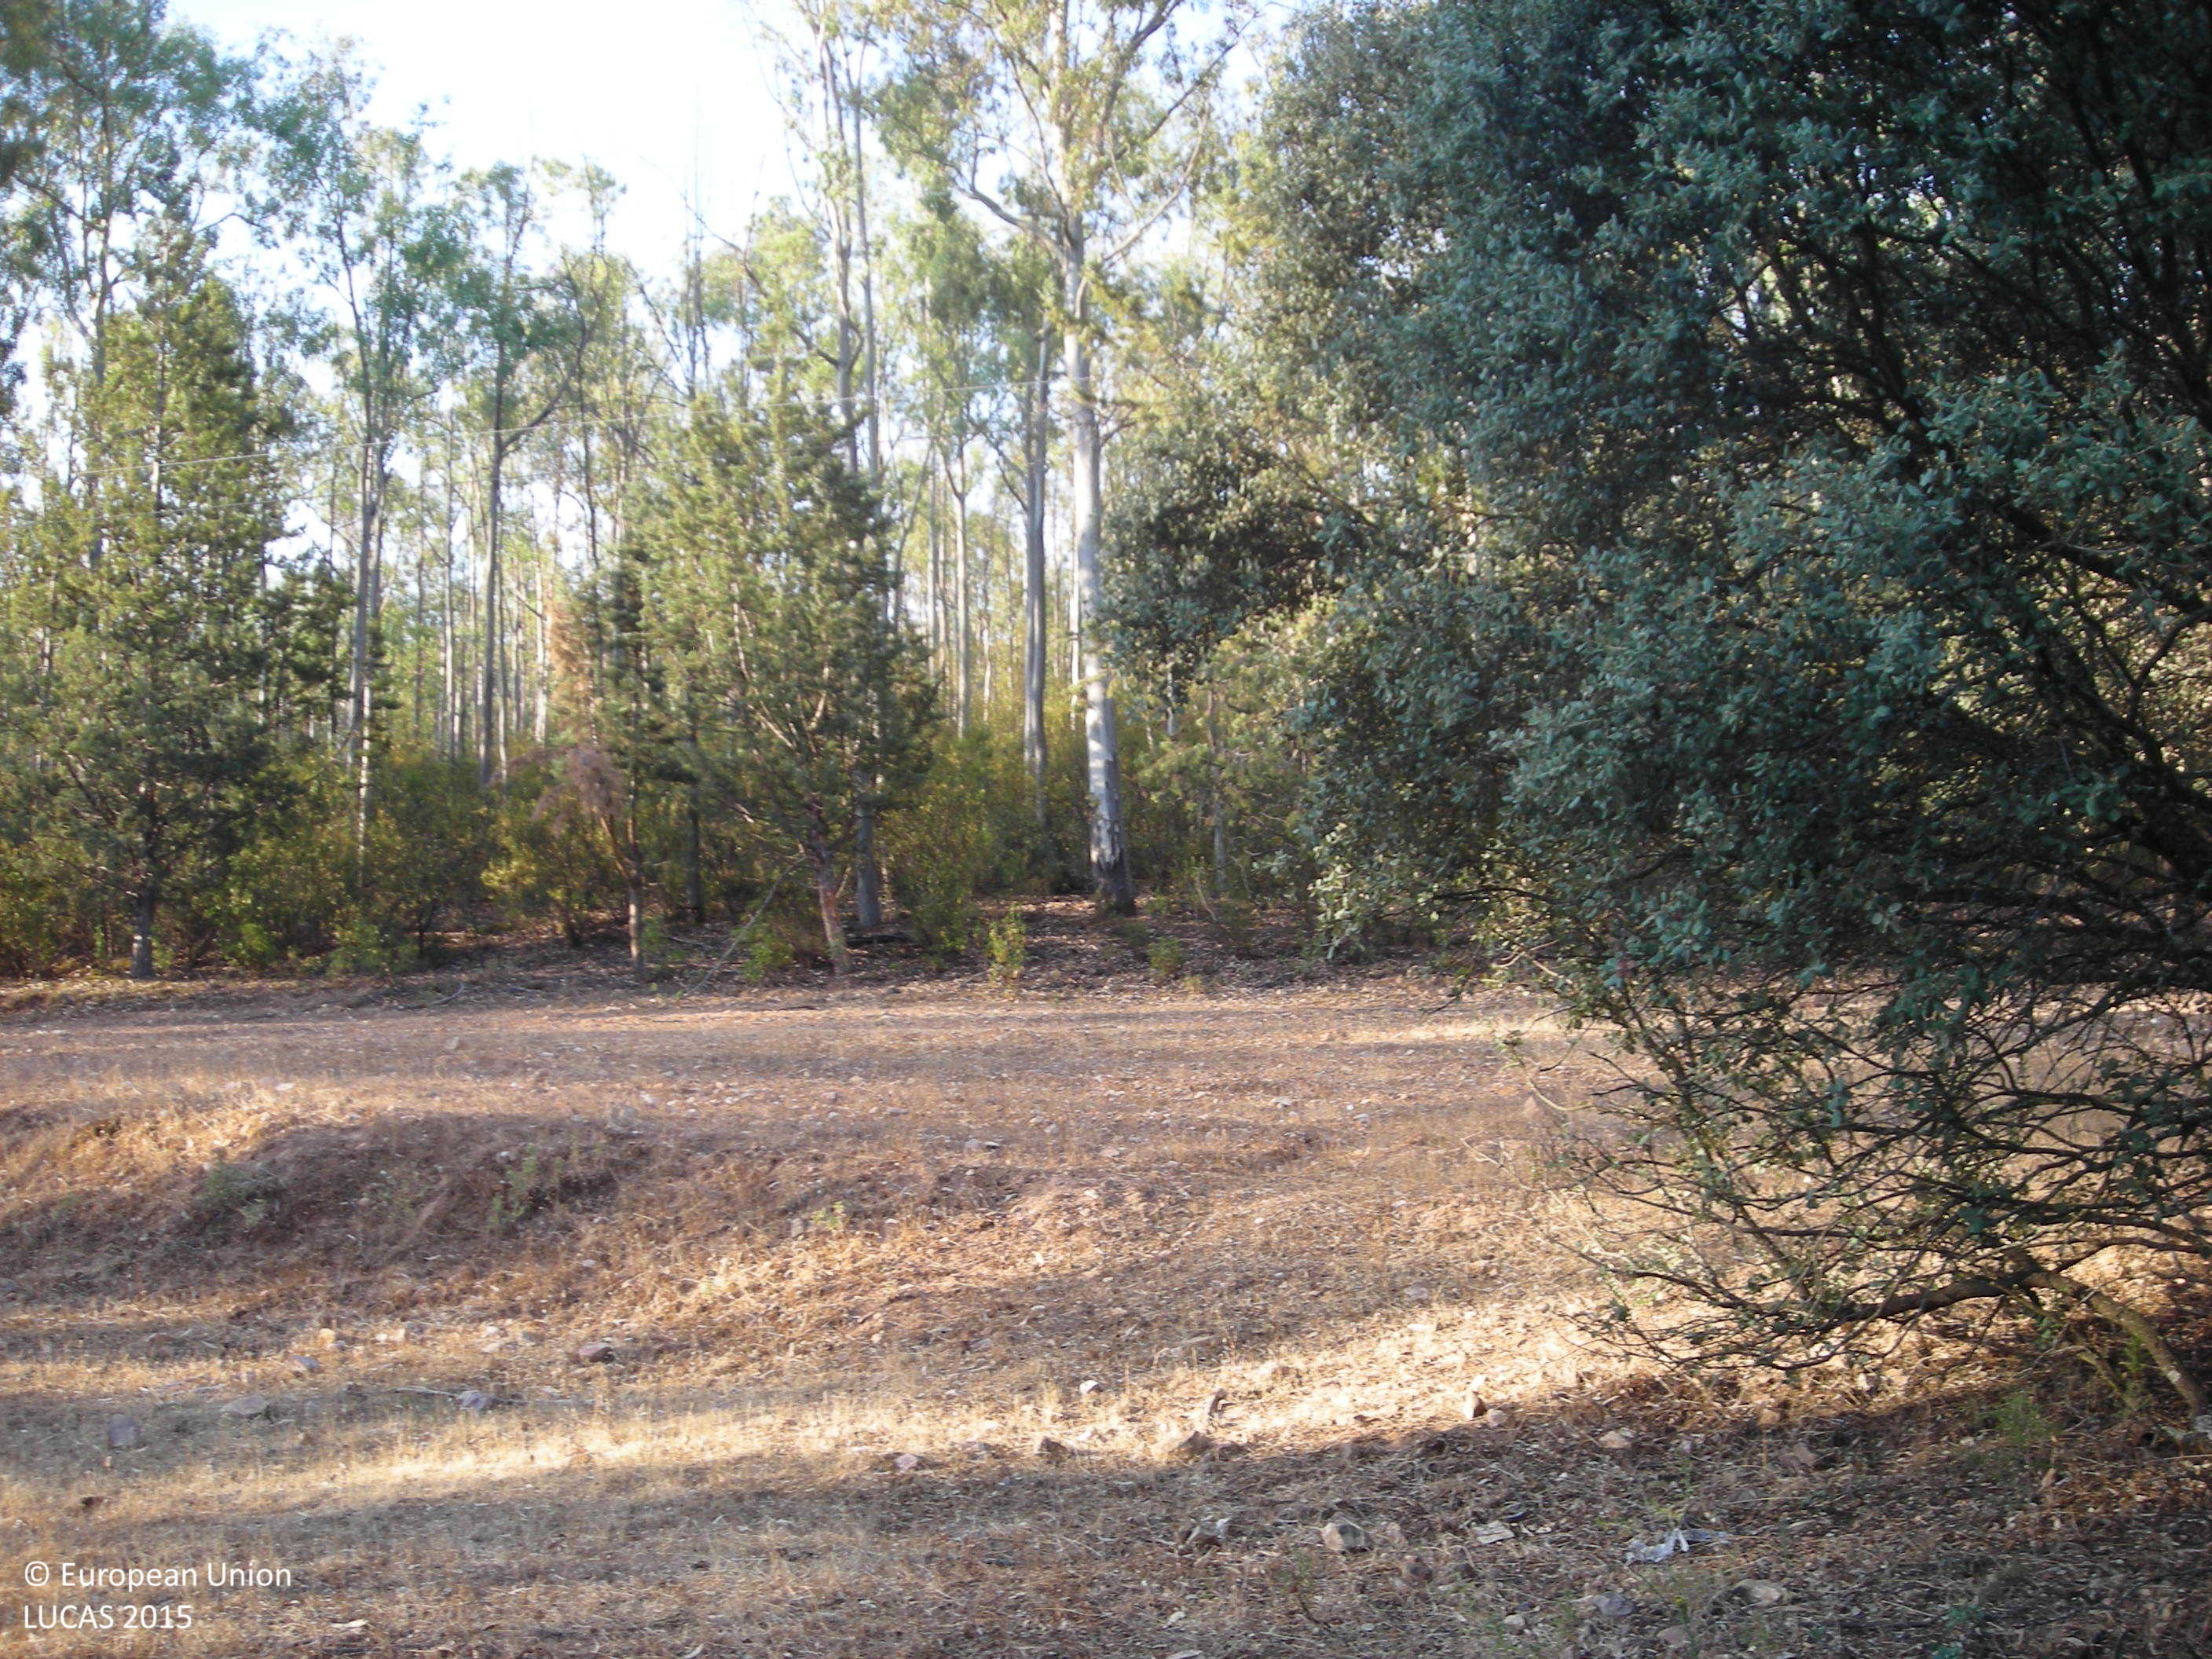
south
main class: Woodland
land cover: Broadleaved woodland
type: exotic forest
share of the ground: > 75 %
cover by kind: broadleaved forest trees 100 %
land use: Forestry
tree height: > 5 m
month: June
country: ES
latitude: 39.0504
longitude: -5.4699
